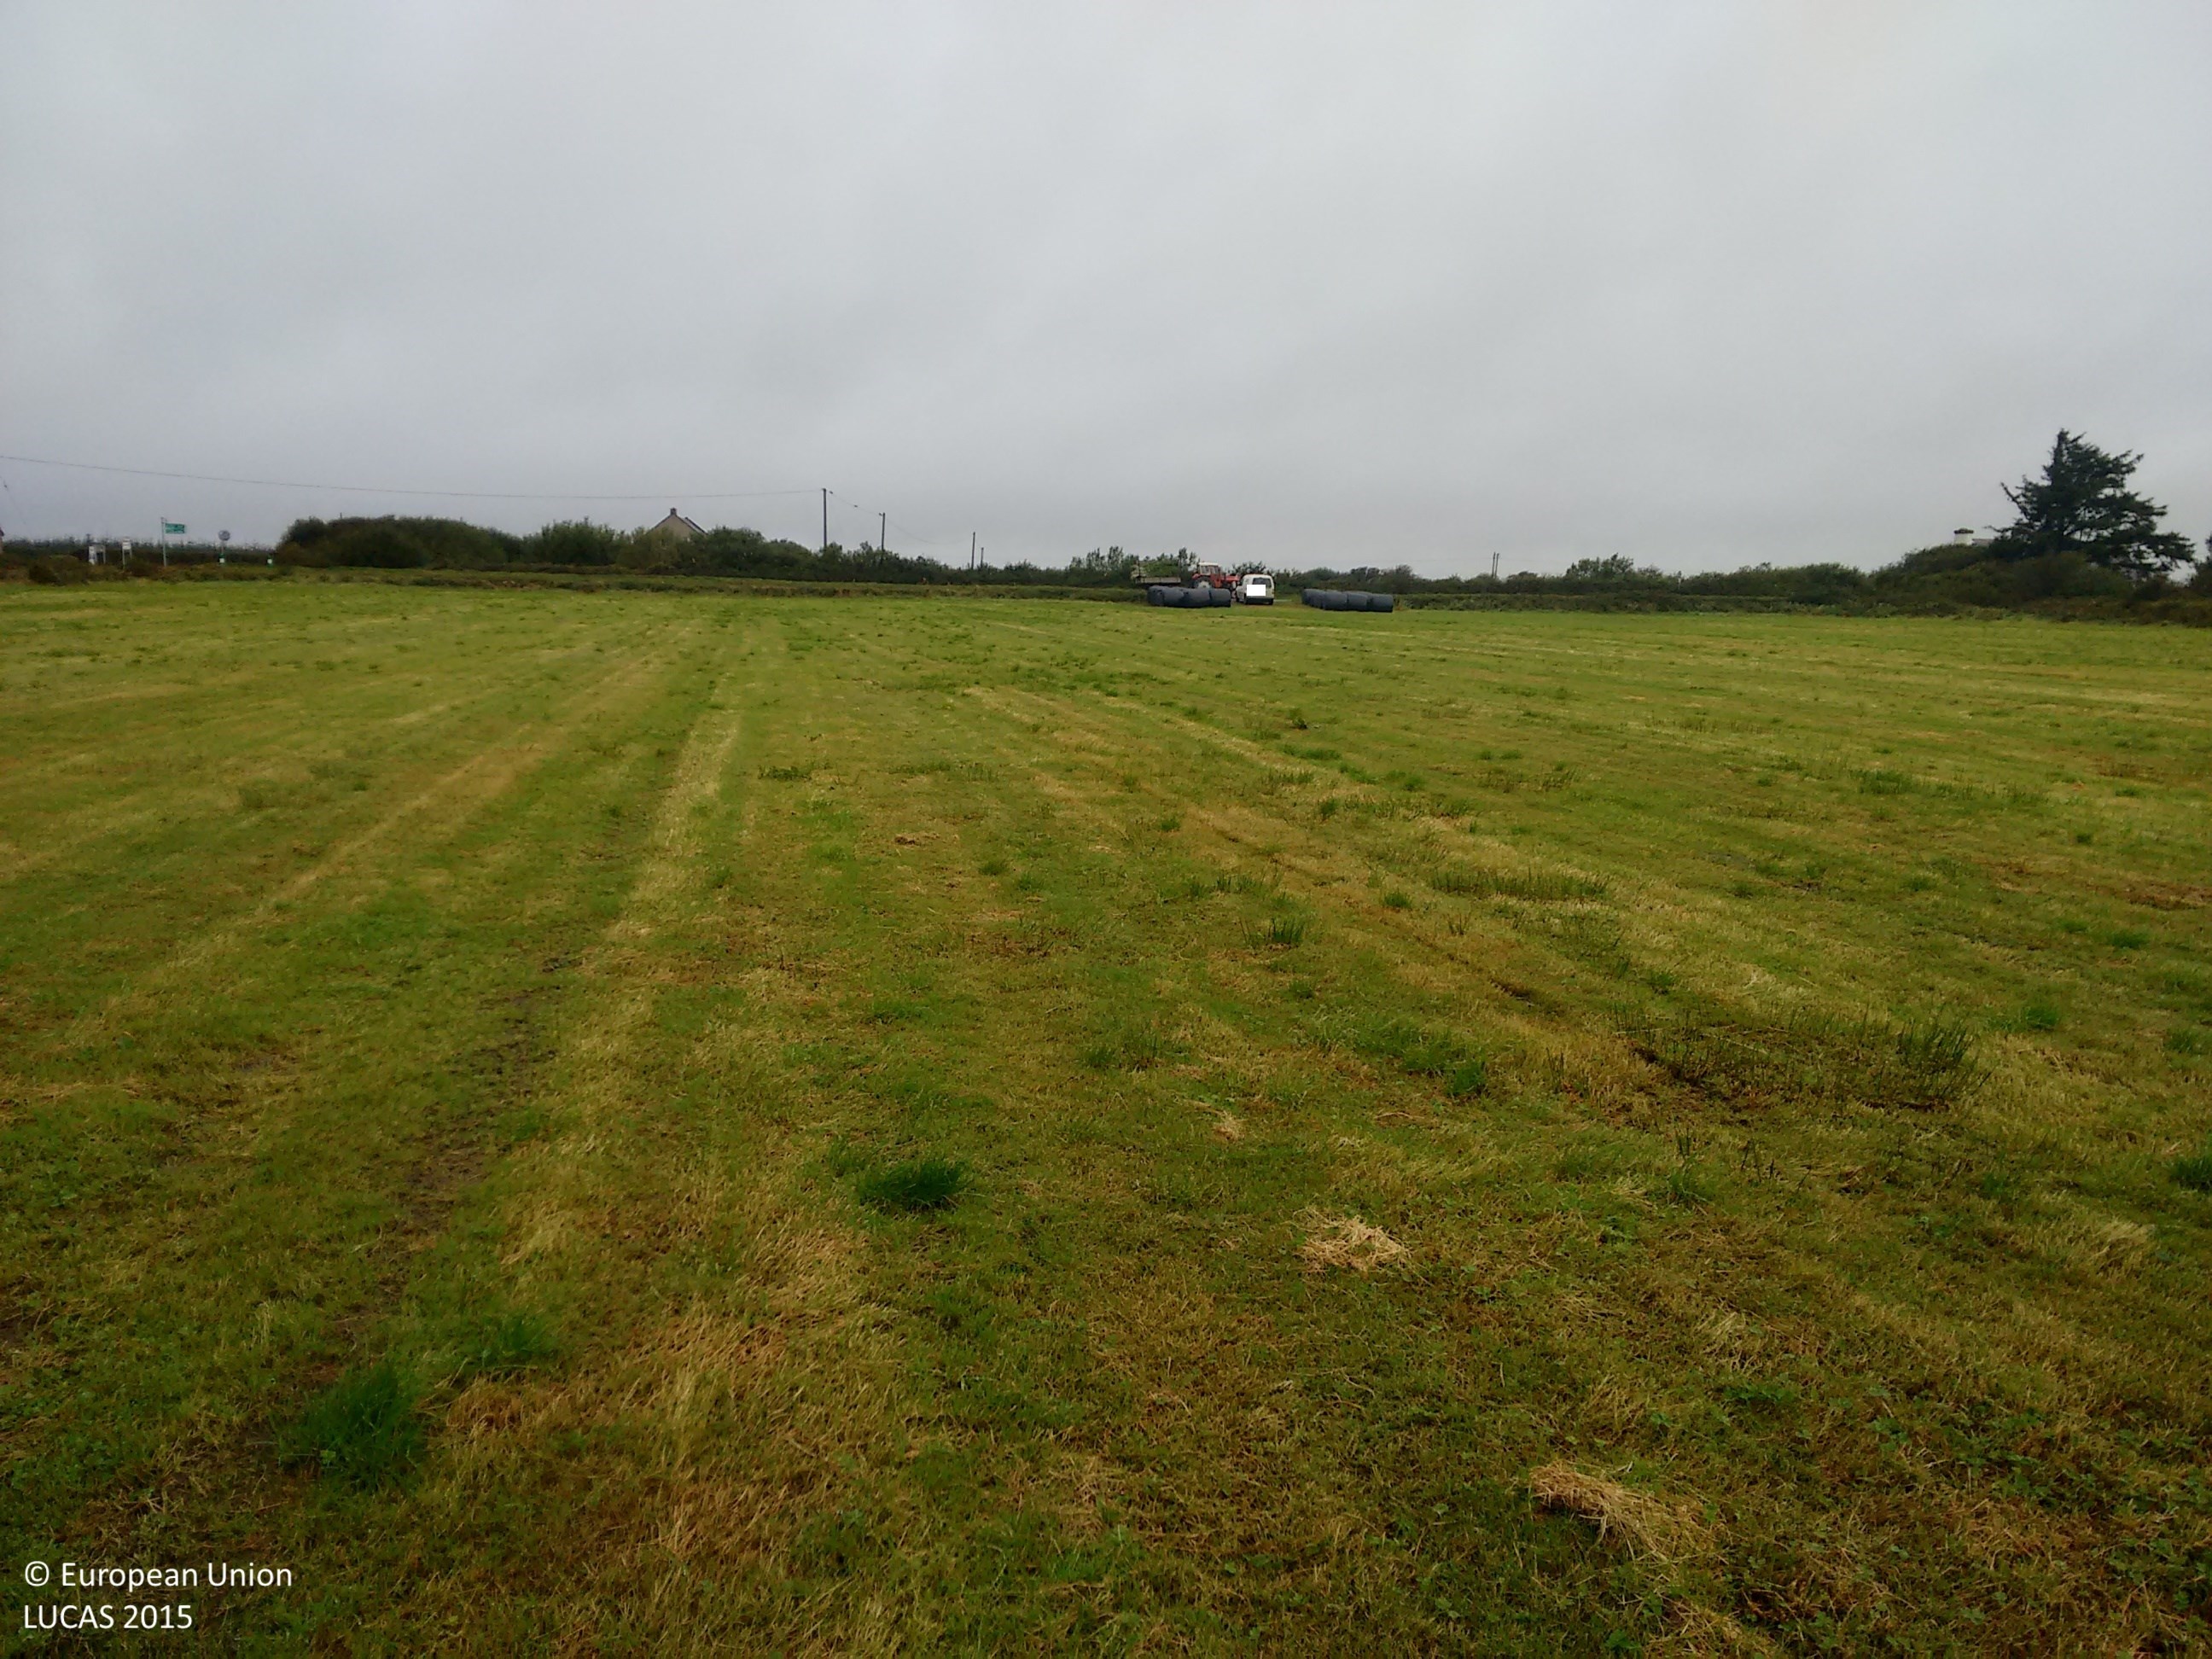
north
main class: Grassland
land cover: Grassland without tree/shrub cover
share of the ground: > 75 %
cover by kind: herbaceous plants 95 %, unconsolidated bare surface 5 %
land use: Agriculture (excluding fallow land and kitchen gardens)
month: September
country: IE
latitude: 52.6717
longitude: -9.5644
